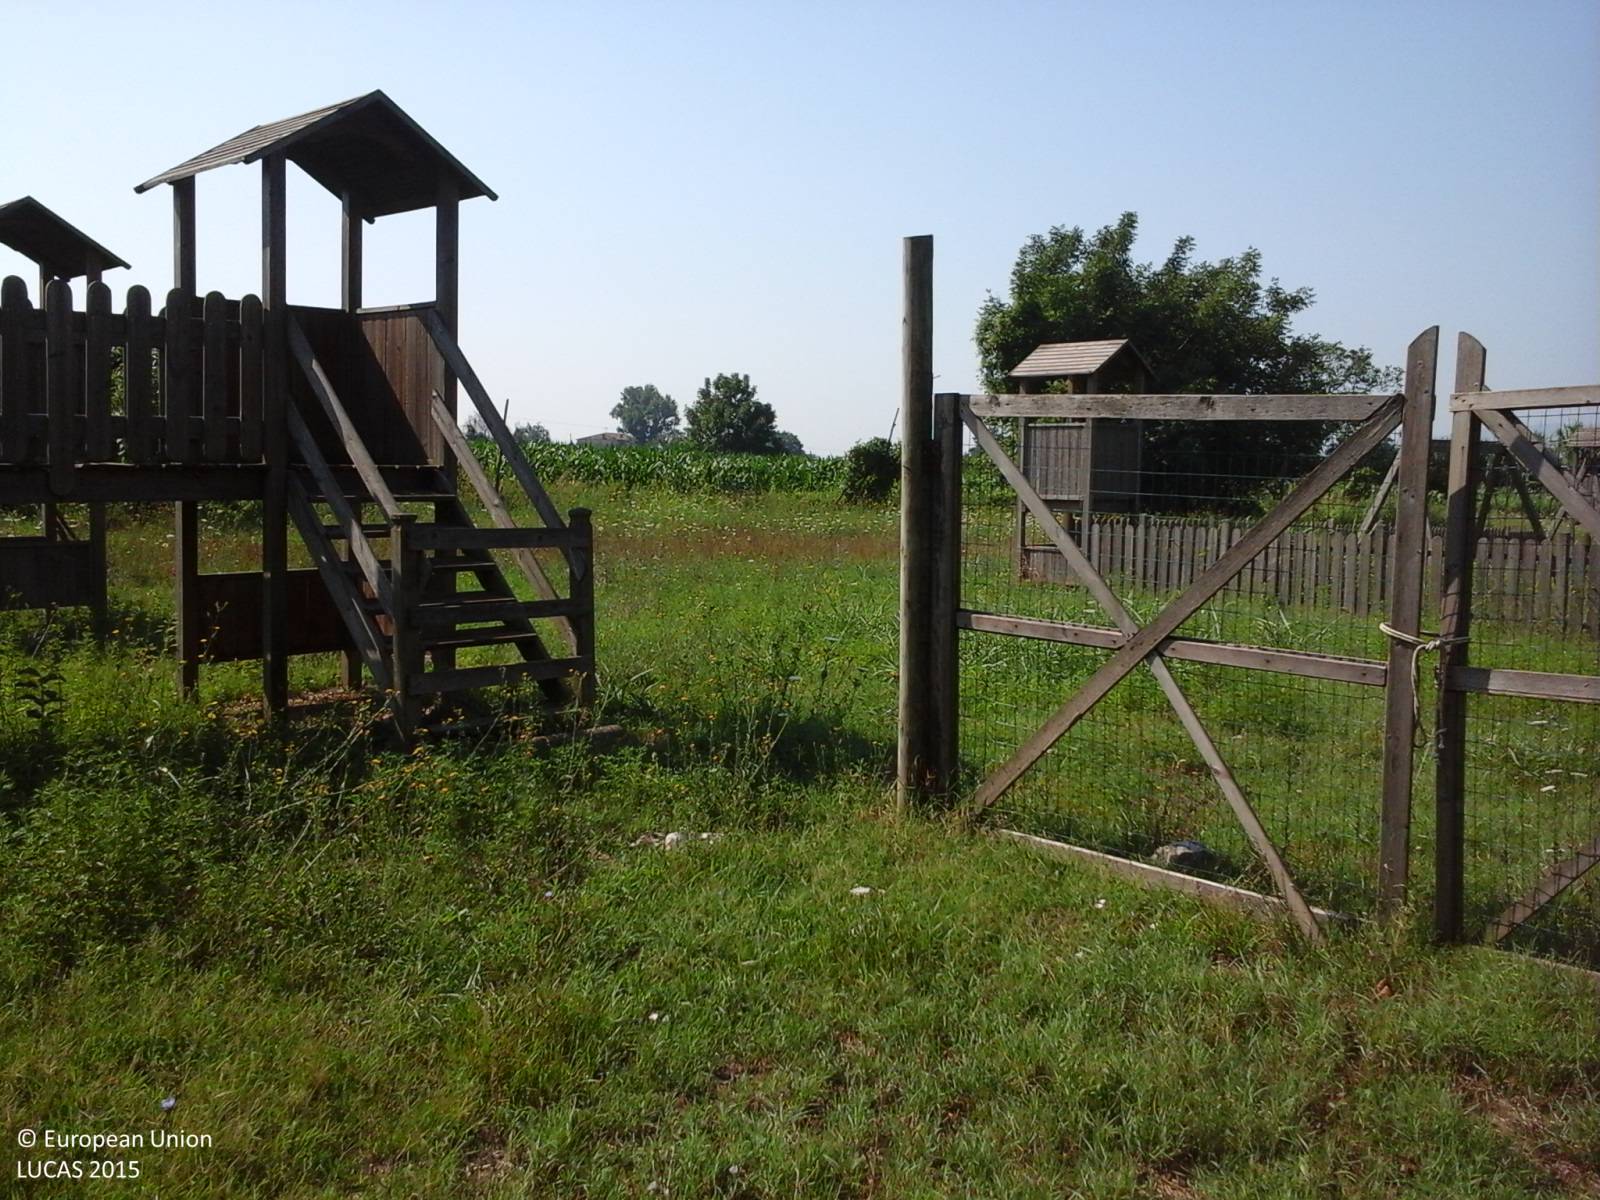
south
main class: Grassland
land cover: Grassland with sparse tree/shrub cover
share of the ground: > 75 %
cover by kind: herbaceous plants 95 %, broadleaved forest trees 5 %
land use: Amenities, museums, leisure
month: August
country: IT
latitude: 41.3474
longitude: 14.3698
